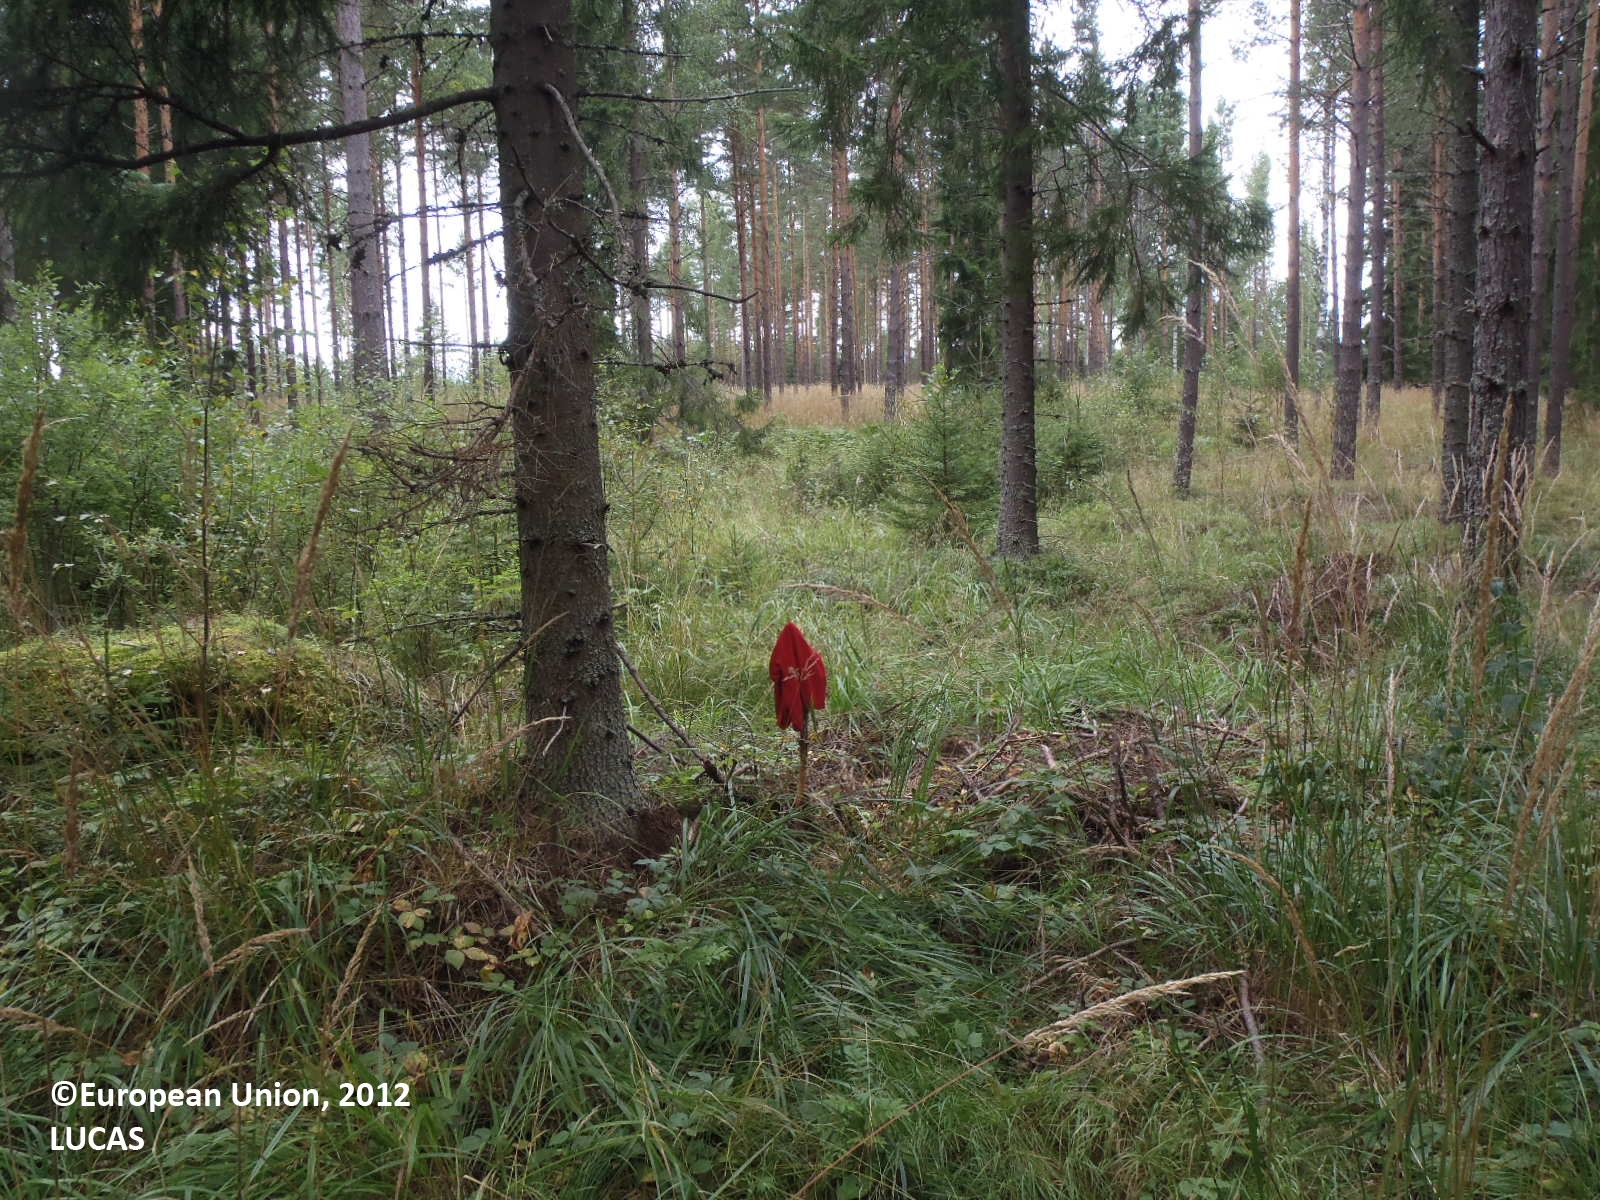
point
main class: Woodland
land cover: Spruce dominated coniferous woodland
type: boreal forest
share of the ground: > 75 %
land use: Forestry
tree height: > 5 m
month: August
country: FI
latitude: 60.7146
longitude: 22.3269
